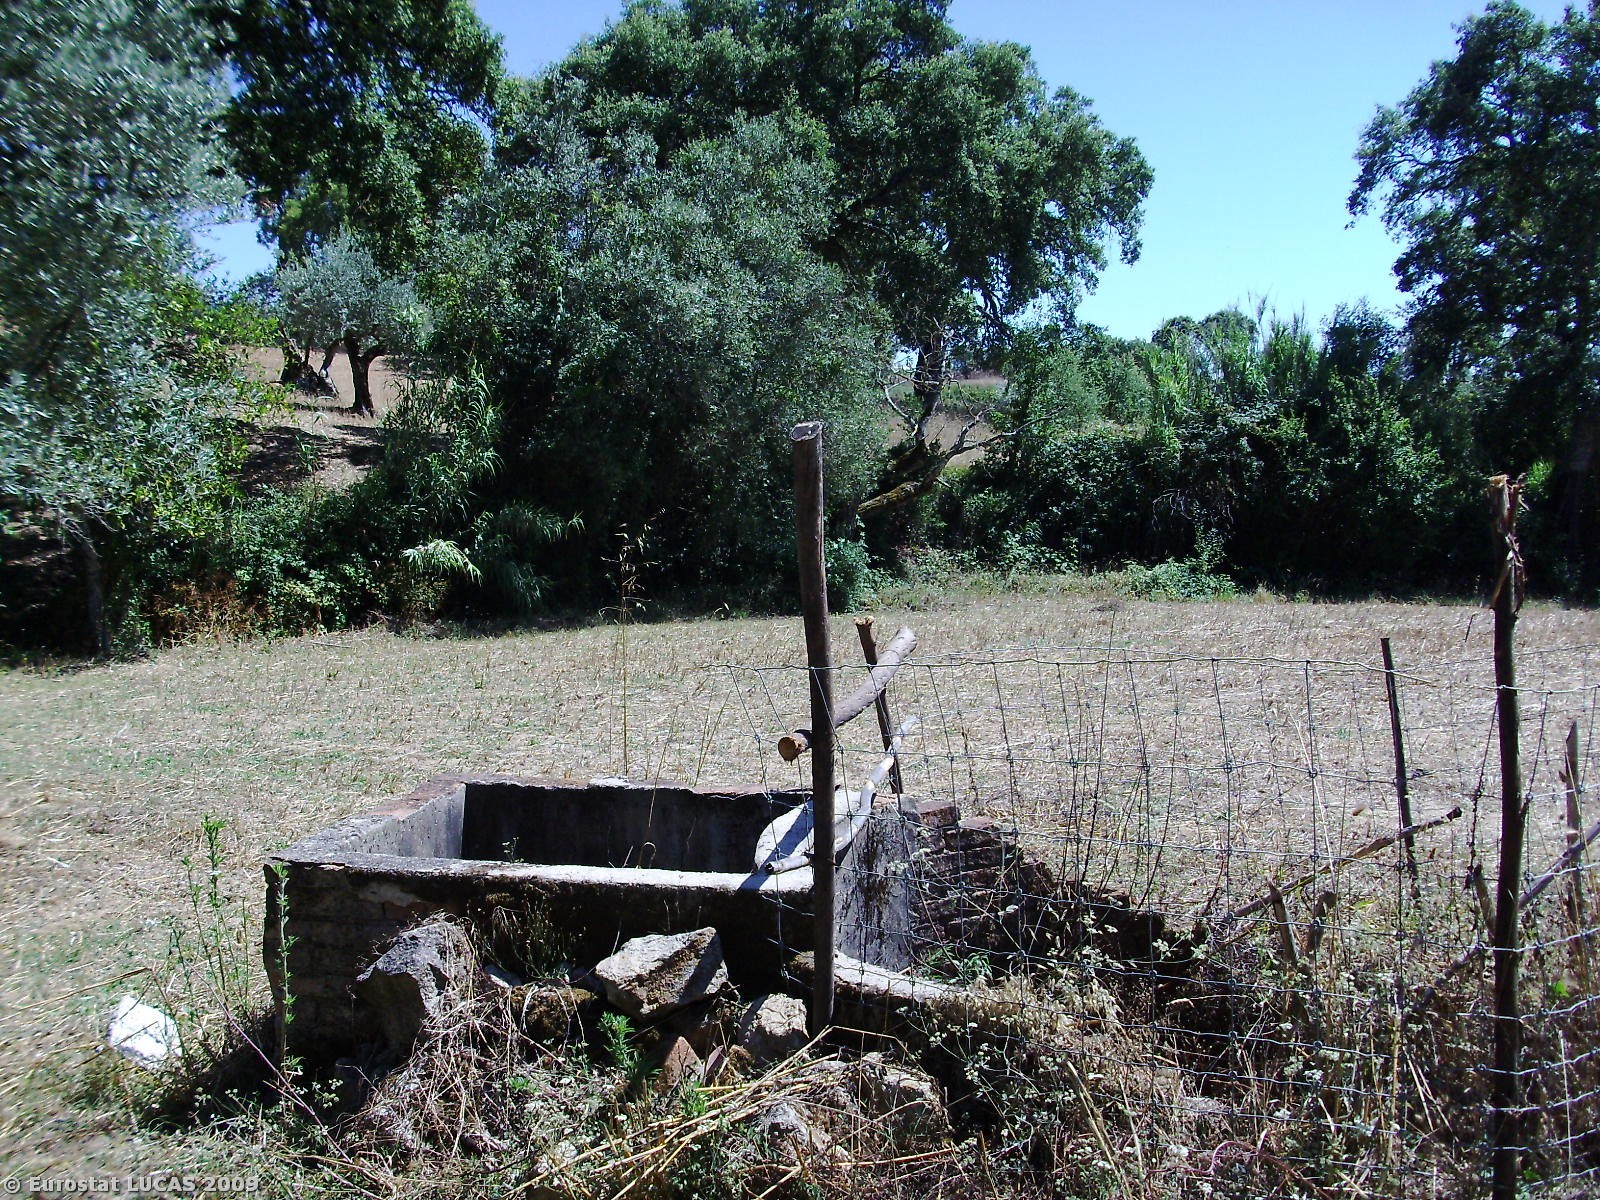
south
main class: Cropland
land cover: Olive groves
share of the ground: 10 - 25 %
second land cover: Spontaneously vegetated surfaces
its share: 50 - 75 %
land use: Agriculture (excluding fallow land and kitchen gardens)
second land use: Fallow land
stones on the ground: 10 - 25 %
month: July
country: PT
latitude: 39.4321
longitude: -8.7956
